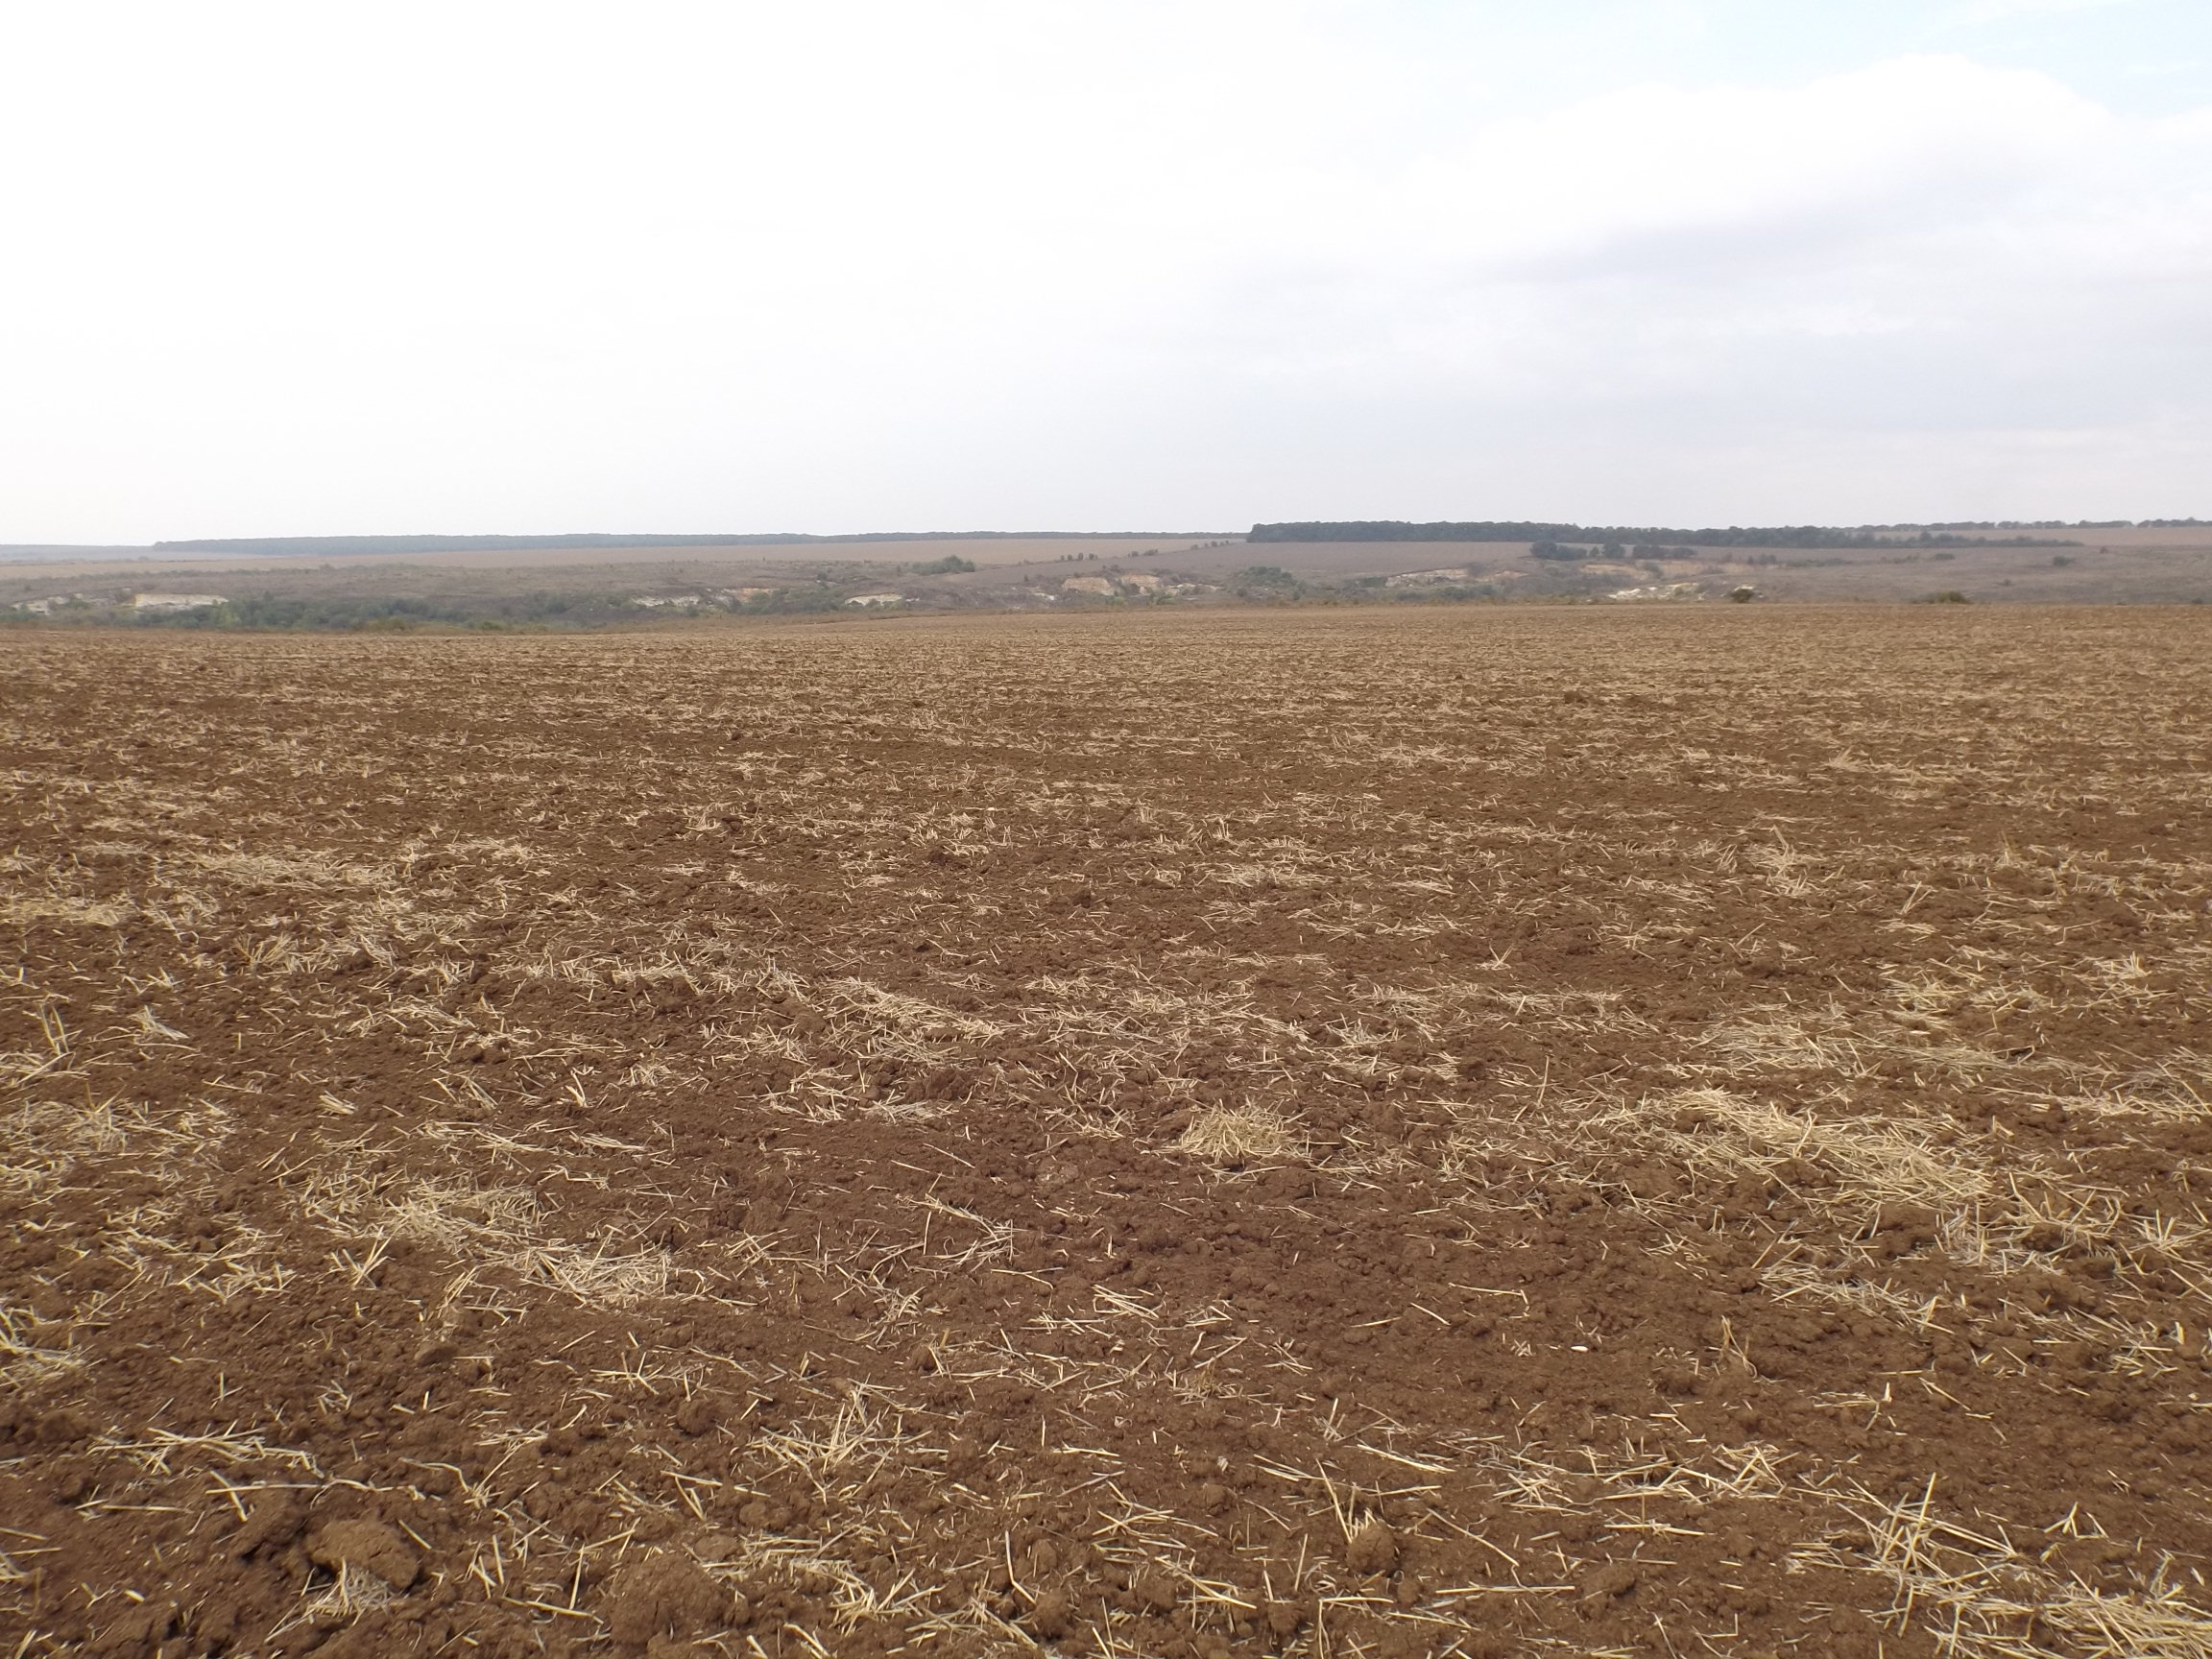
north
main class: Cropland
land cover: Common wheat
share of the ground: < 10 %
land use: Agriculture (excluding fallow land and kitchen gardens)
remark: Harvested field
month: September
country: BG
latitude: 43.4292
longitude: 27.7656
